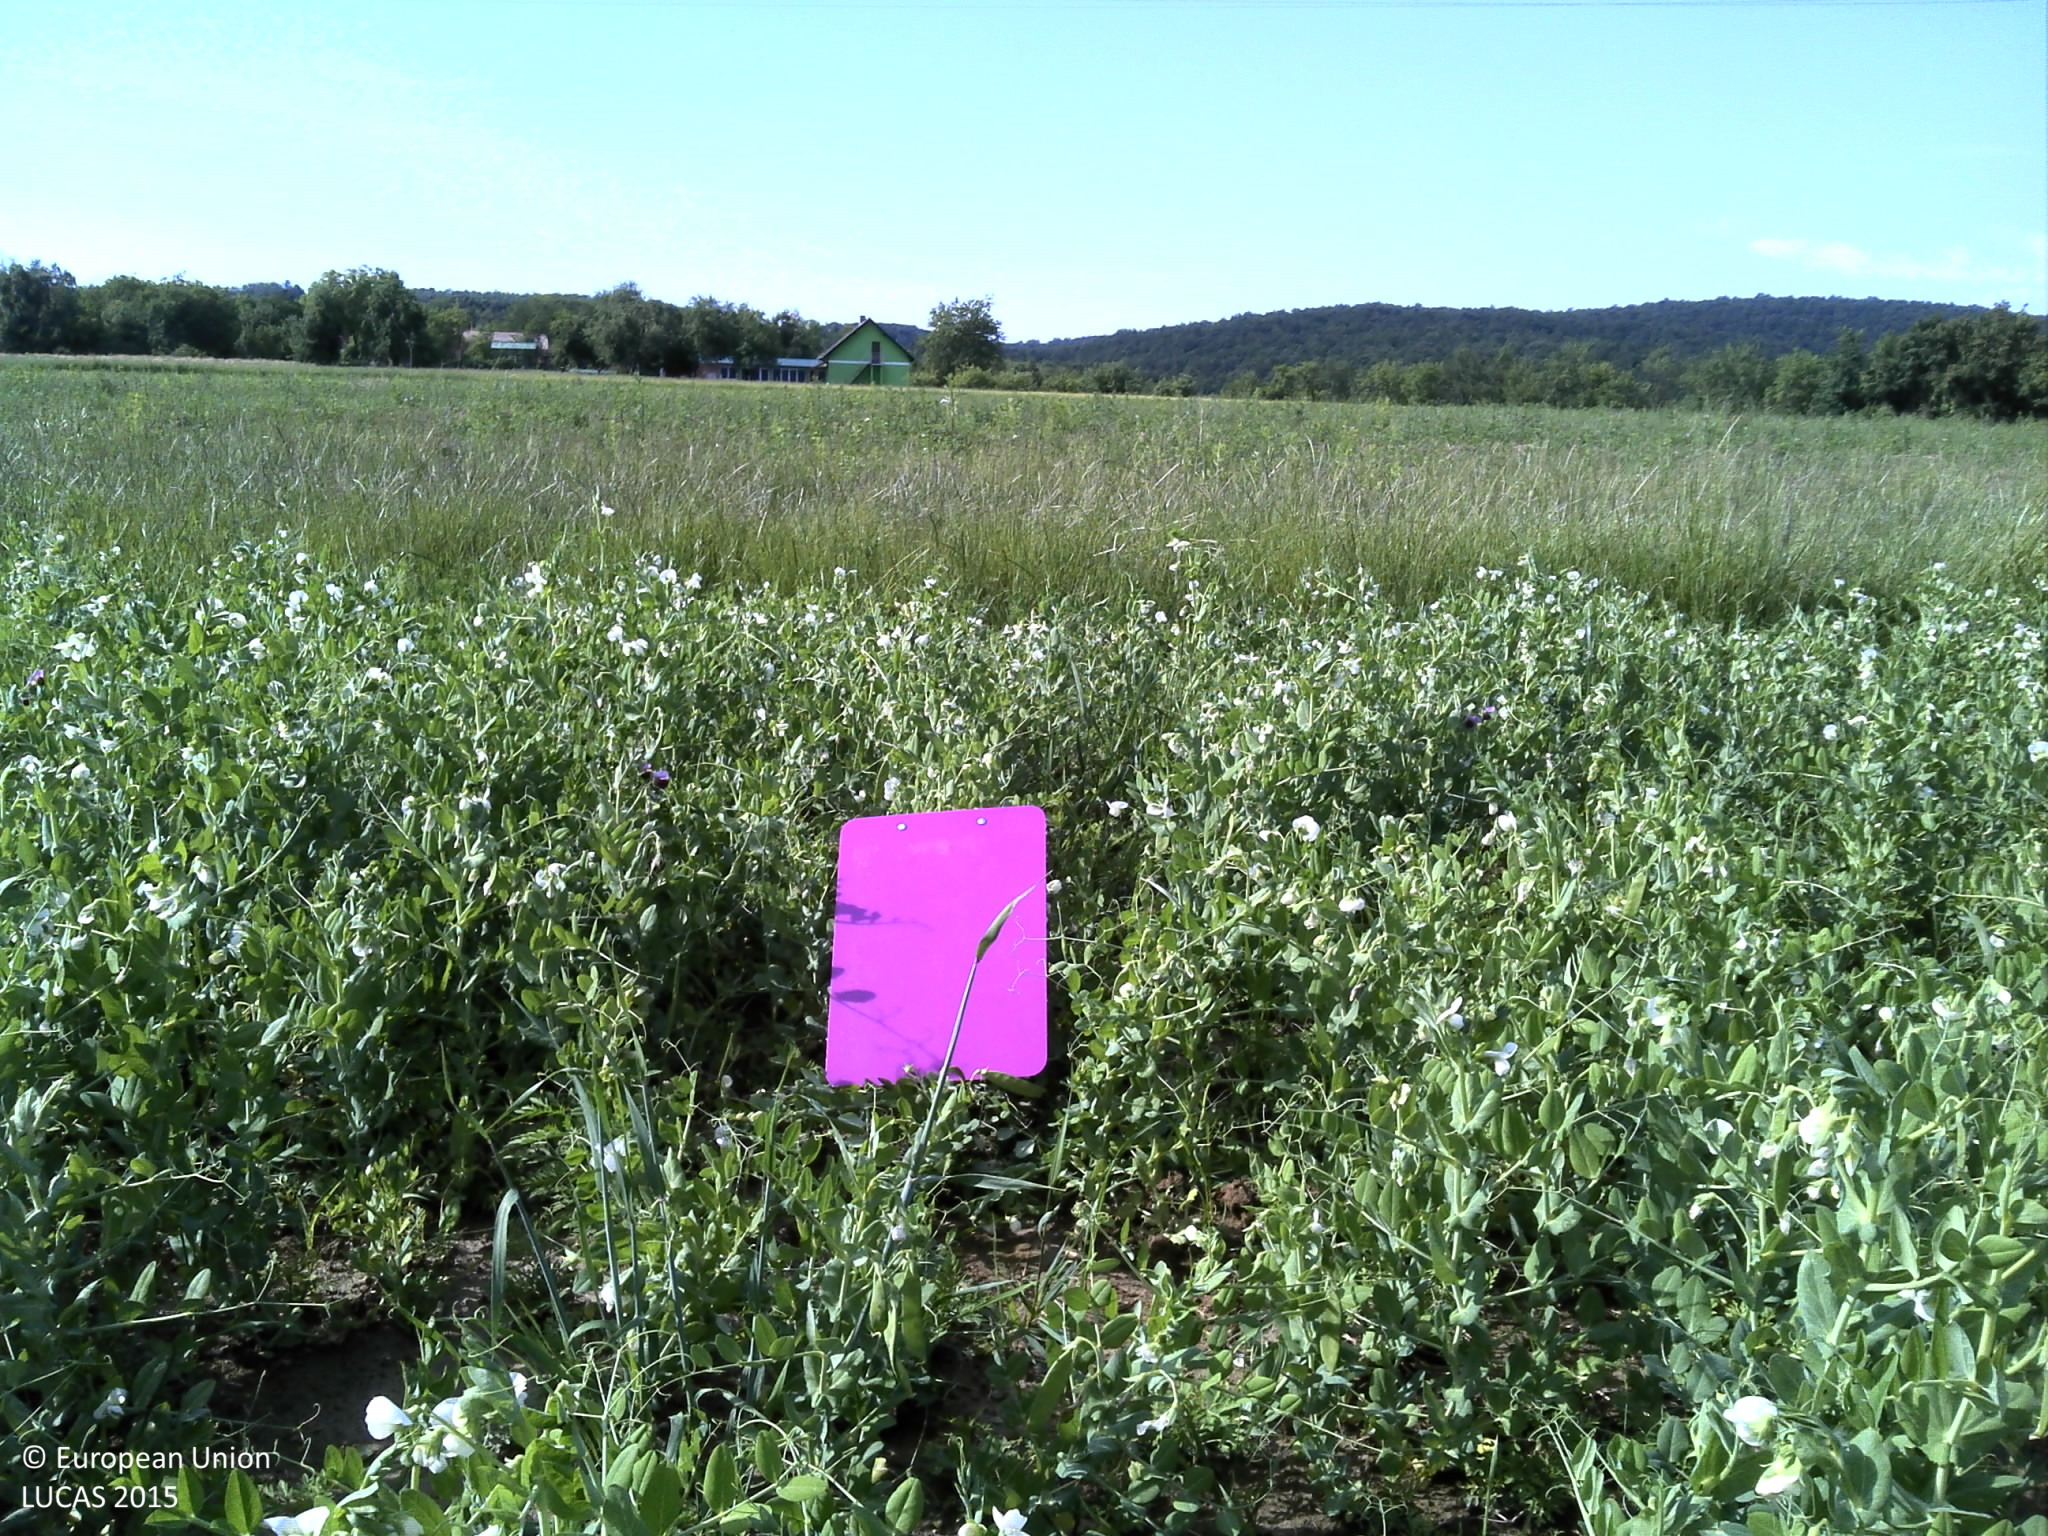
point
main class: Cropland
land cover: Dry pulses
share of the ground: 50 - 75 %
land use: Agriculture (excluding fallow land and kitchen gardens)
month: May
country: HR
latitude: 45.3609
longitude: 18.0333
